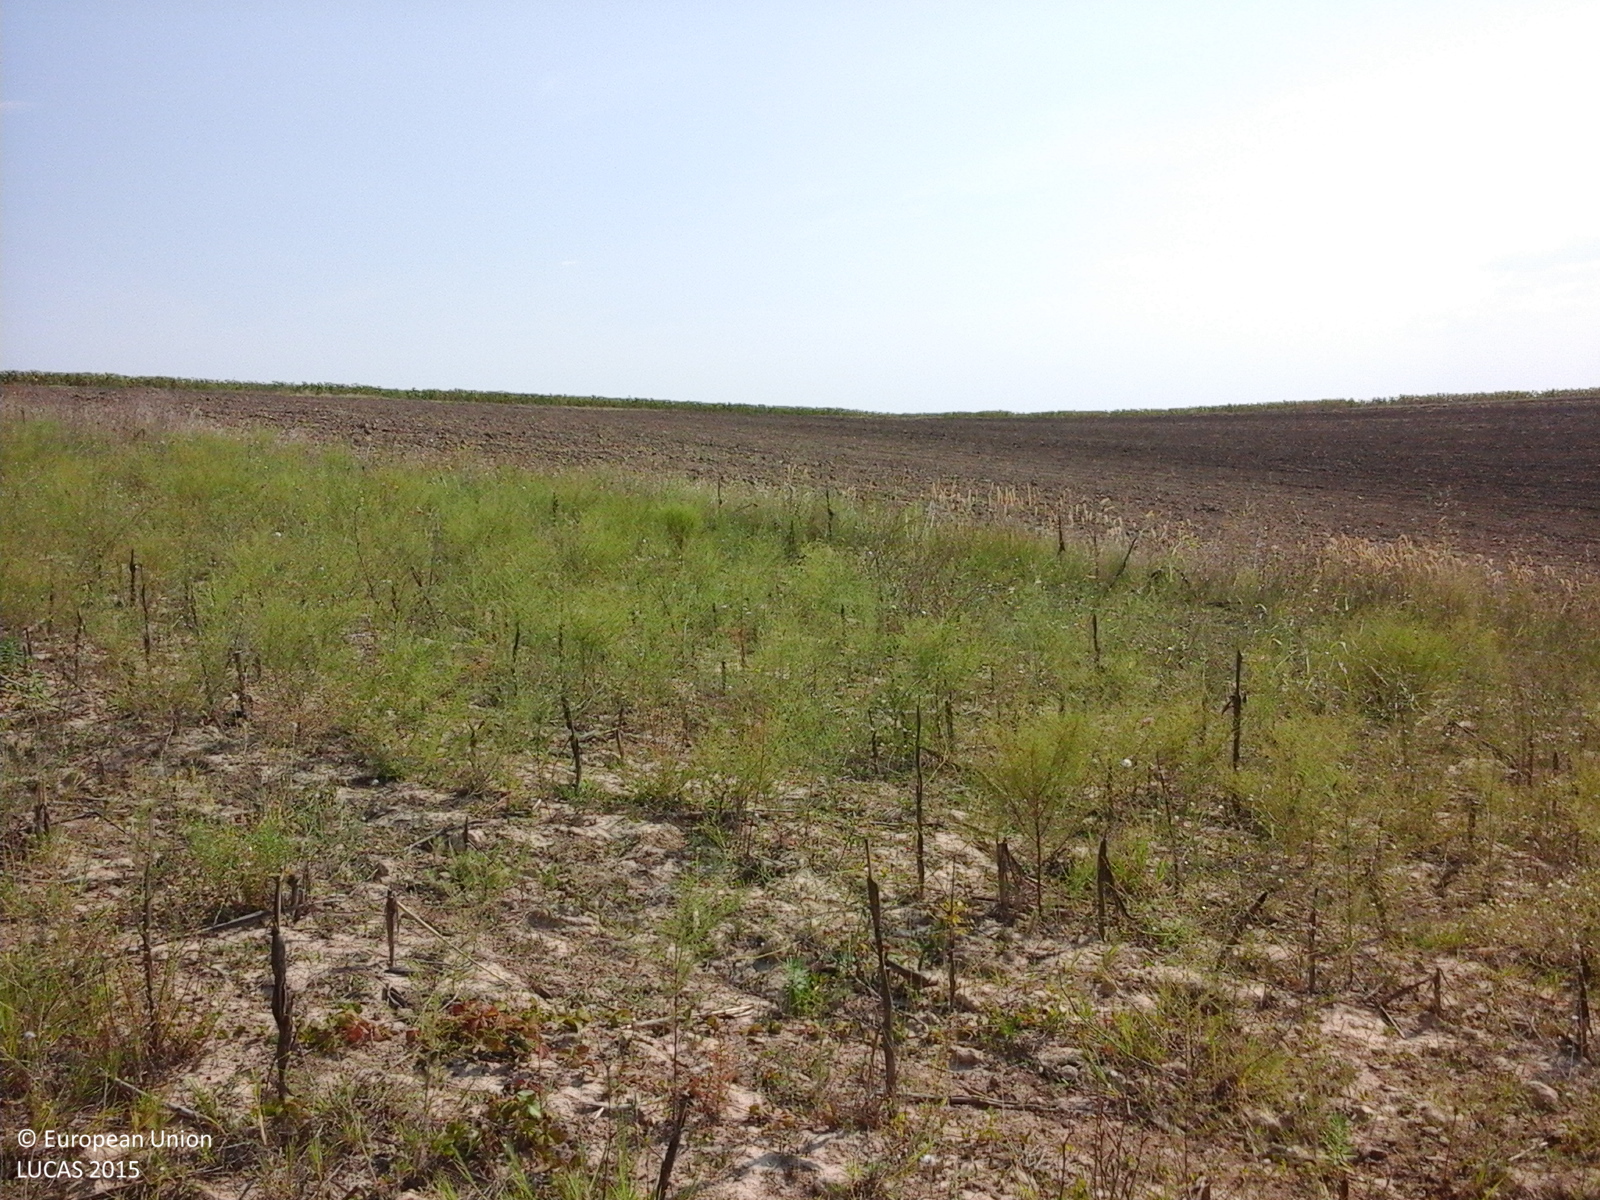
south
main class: Grassland
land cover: Spontaneously vegetated surfaces
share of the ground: 10 - 25 %
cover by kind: herbaceous plants 100 %
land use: Fallow land
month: August
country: RO
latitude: 44.1886
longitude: 27.9554
